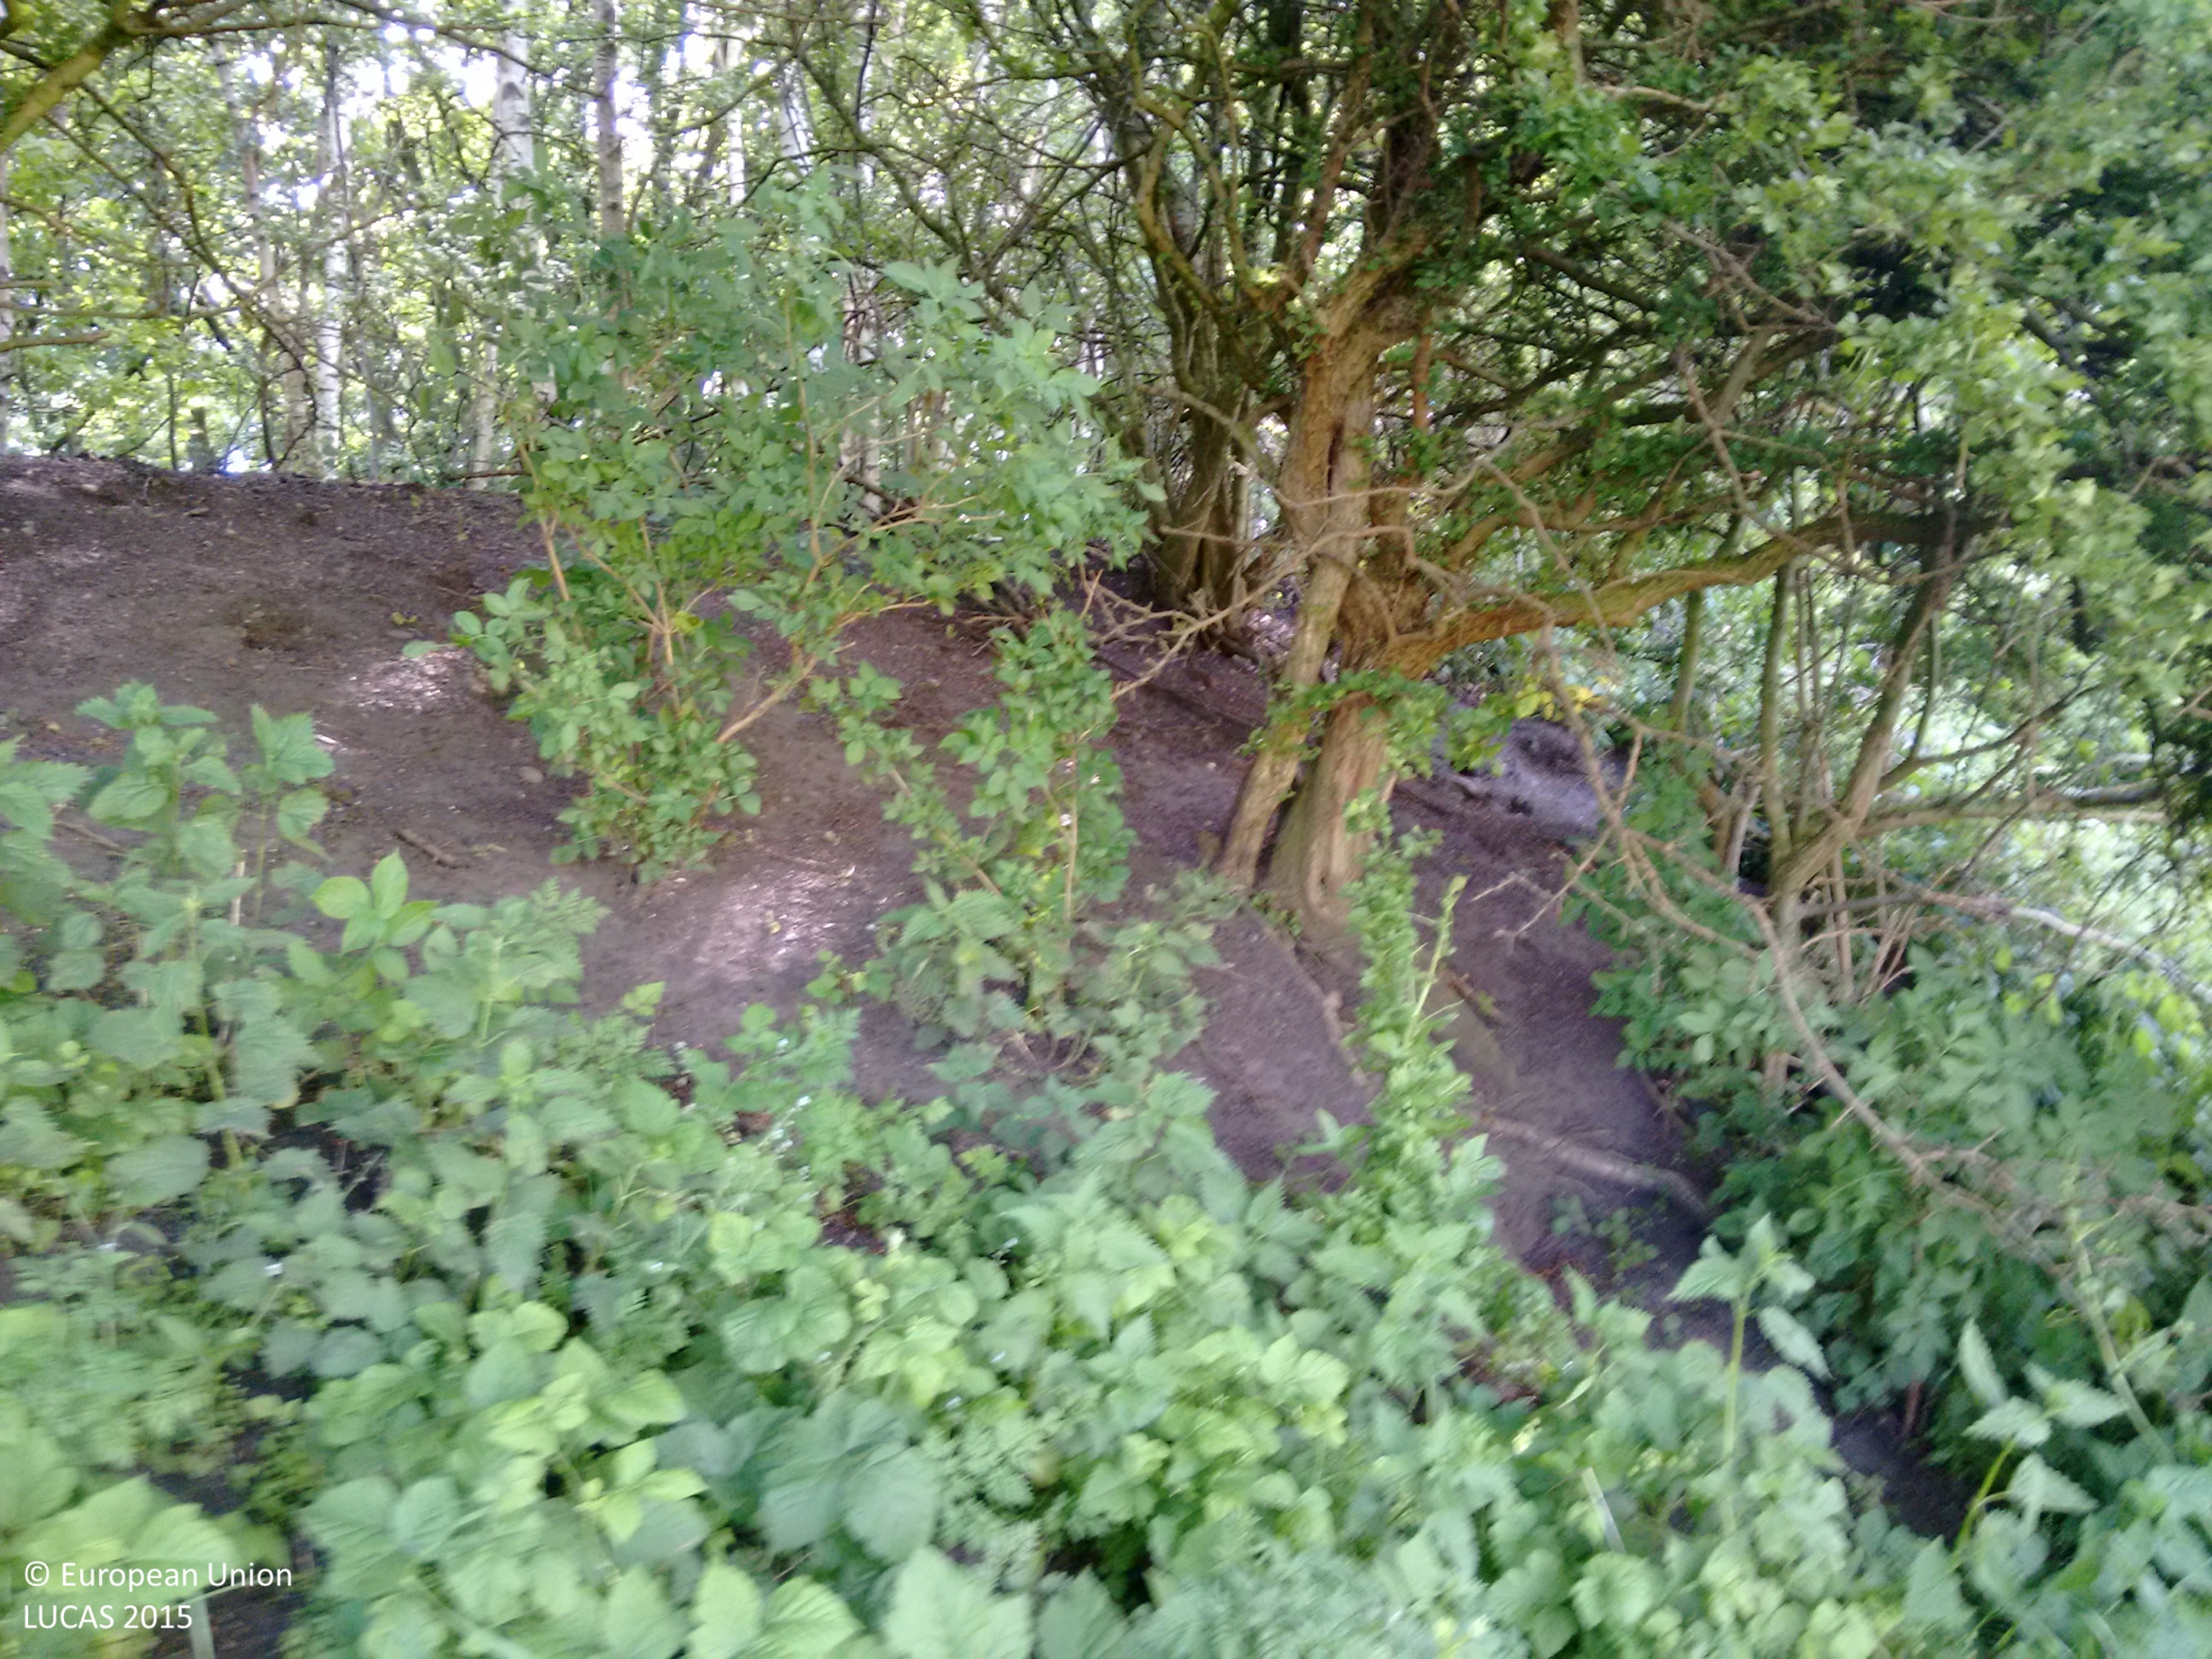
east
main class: Grassland
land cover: Grassland without tree/shrub cover
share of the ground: > 75 %
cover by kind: herbaceous plants 100 %
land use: Agriculture (excluding fallow land and kitchen gardens)
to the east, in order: Grassland without tree/shrub cover; Fences; Other mixed woodland; Fences; Grassland without tree/shrub cover; Other mixed woodland
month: June
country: GB
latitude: 53.8890
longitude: -1.2907
